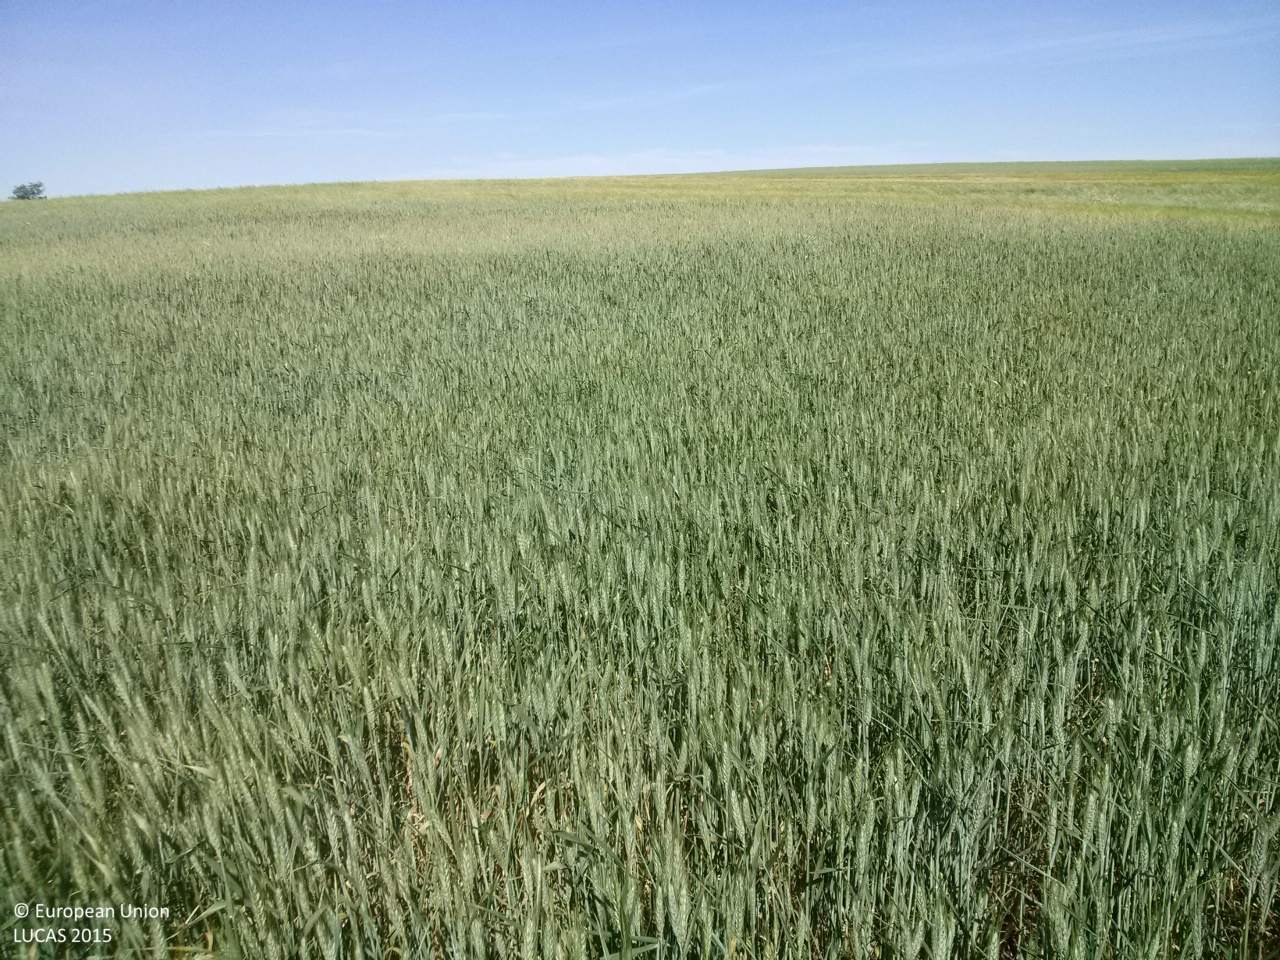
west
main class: Cropland
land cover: Common wheat
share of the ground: > 75 %
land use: Agriculture (excluding fallow land and kitchen gardens)
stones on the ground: < 10 %
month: May
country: ES
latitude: 40.0132
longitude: -2.7796
